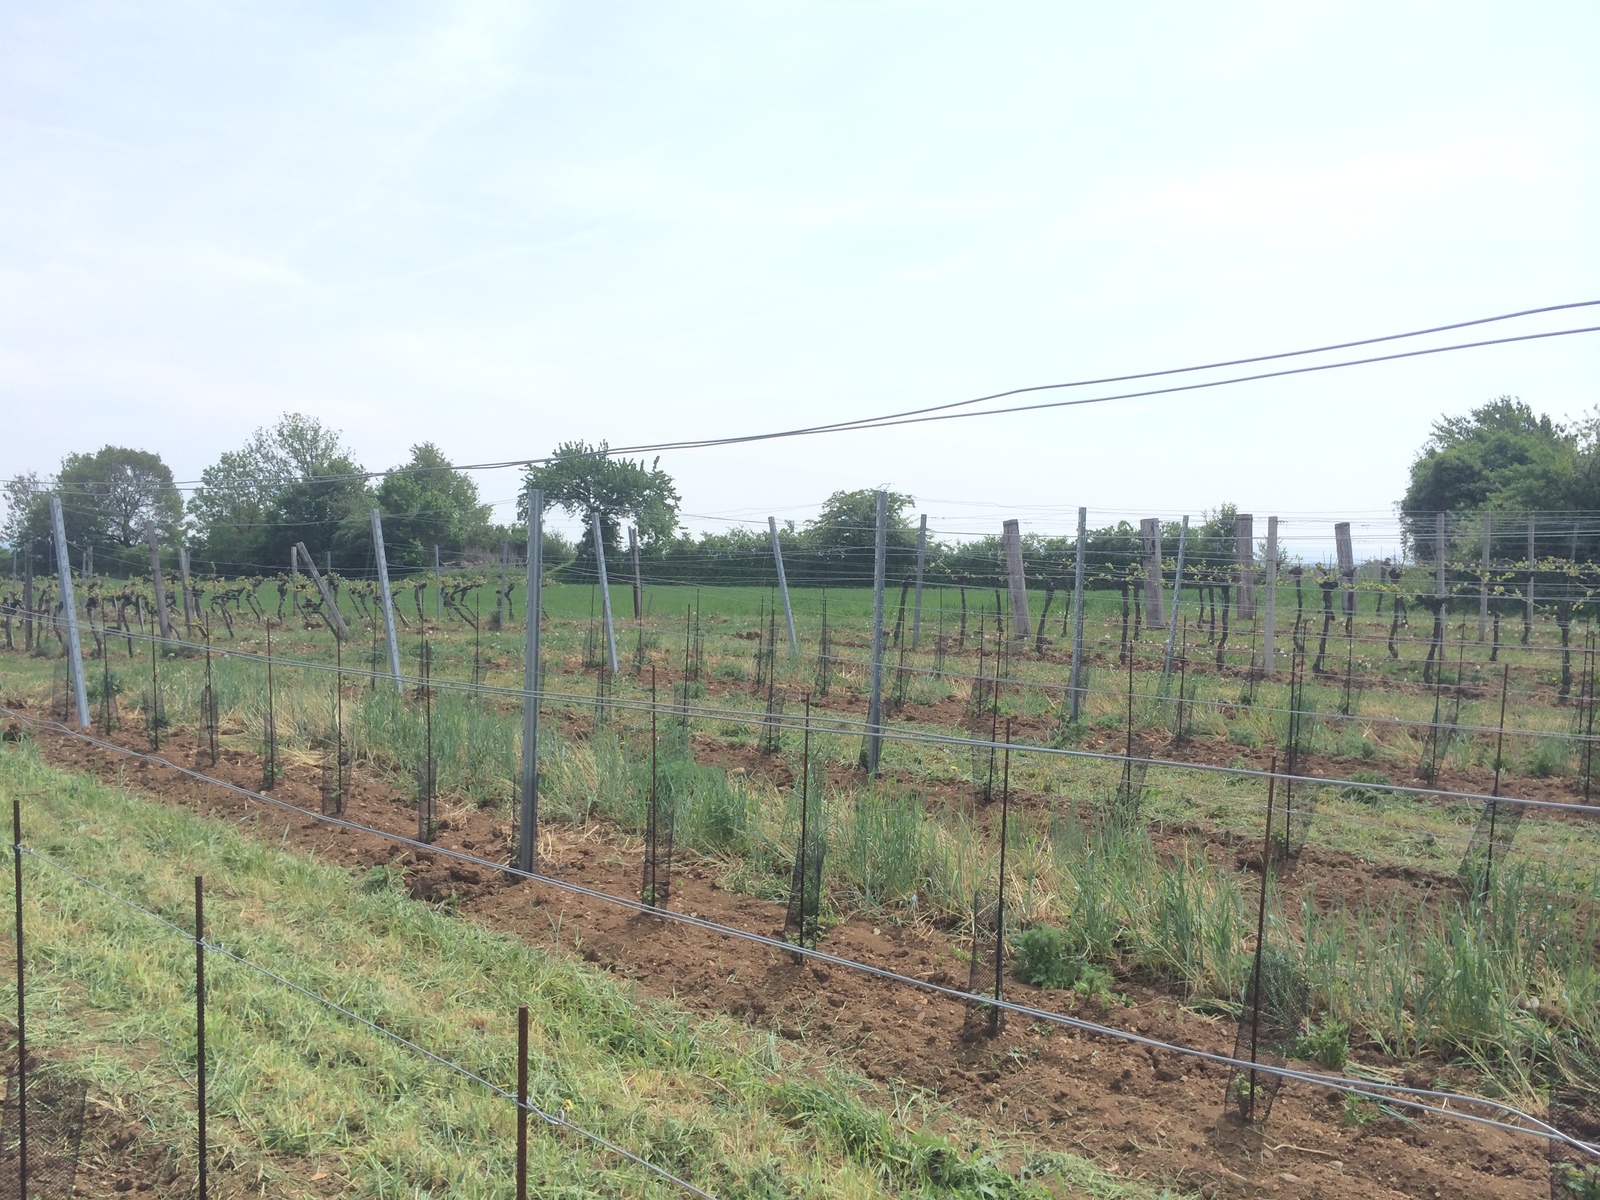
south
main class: Cropland
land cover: Vineyards
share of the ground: > 75 %
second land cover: Grassland without tree/shrub cover
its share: > 75 %
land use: Agriculture (excluding fallow land and kitchen gardens)
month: May
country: AT
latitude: 47.9406
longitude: 16.2021
